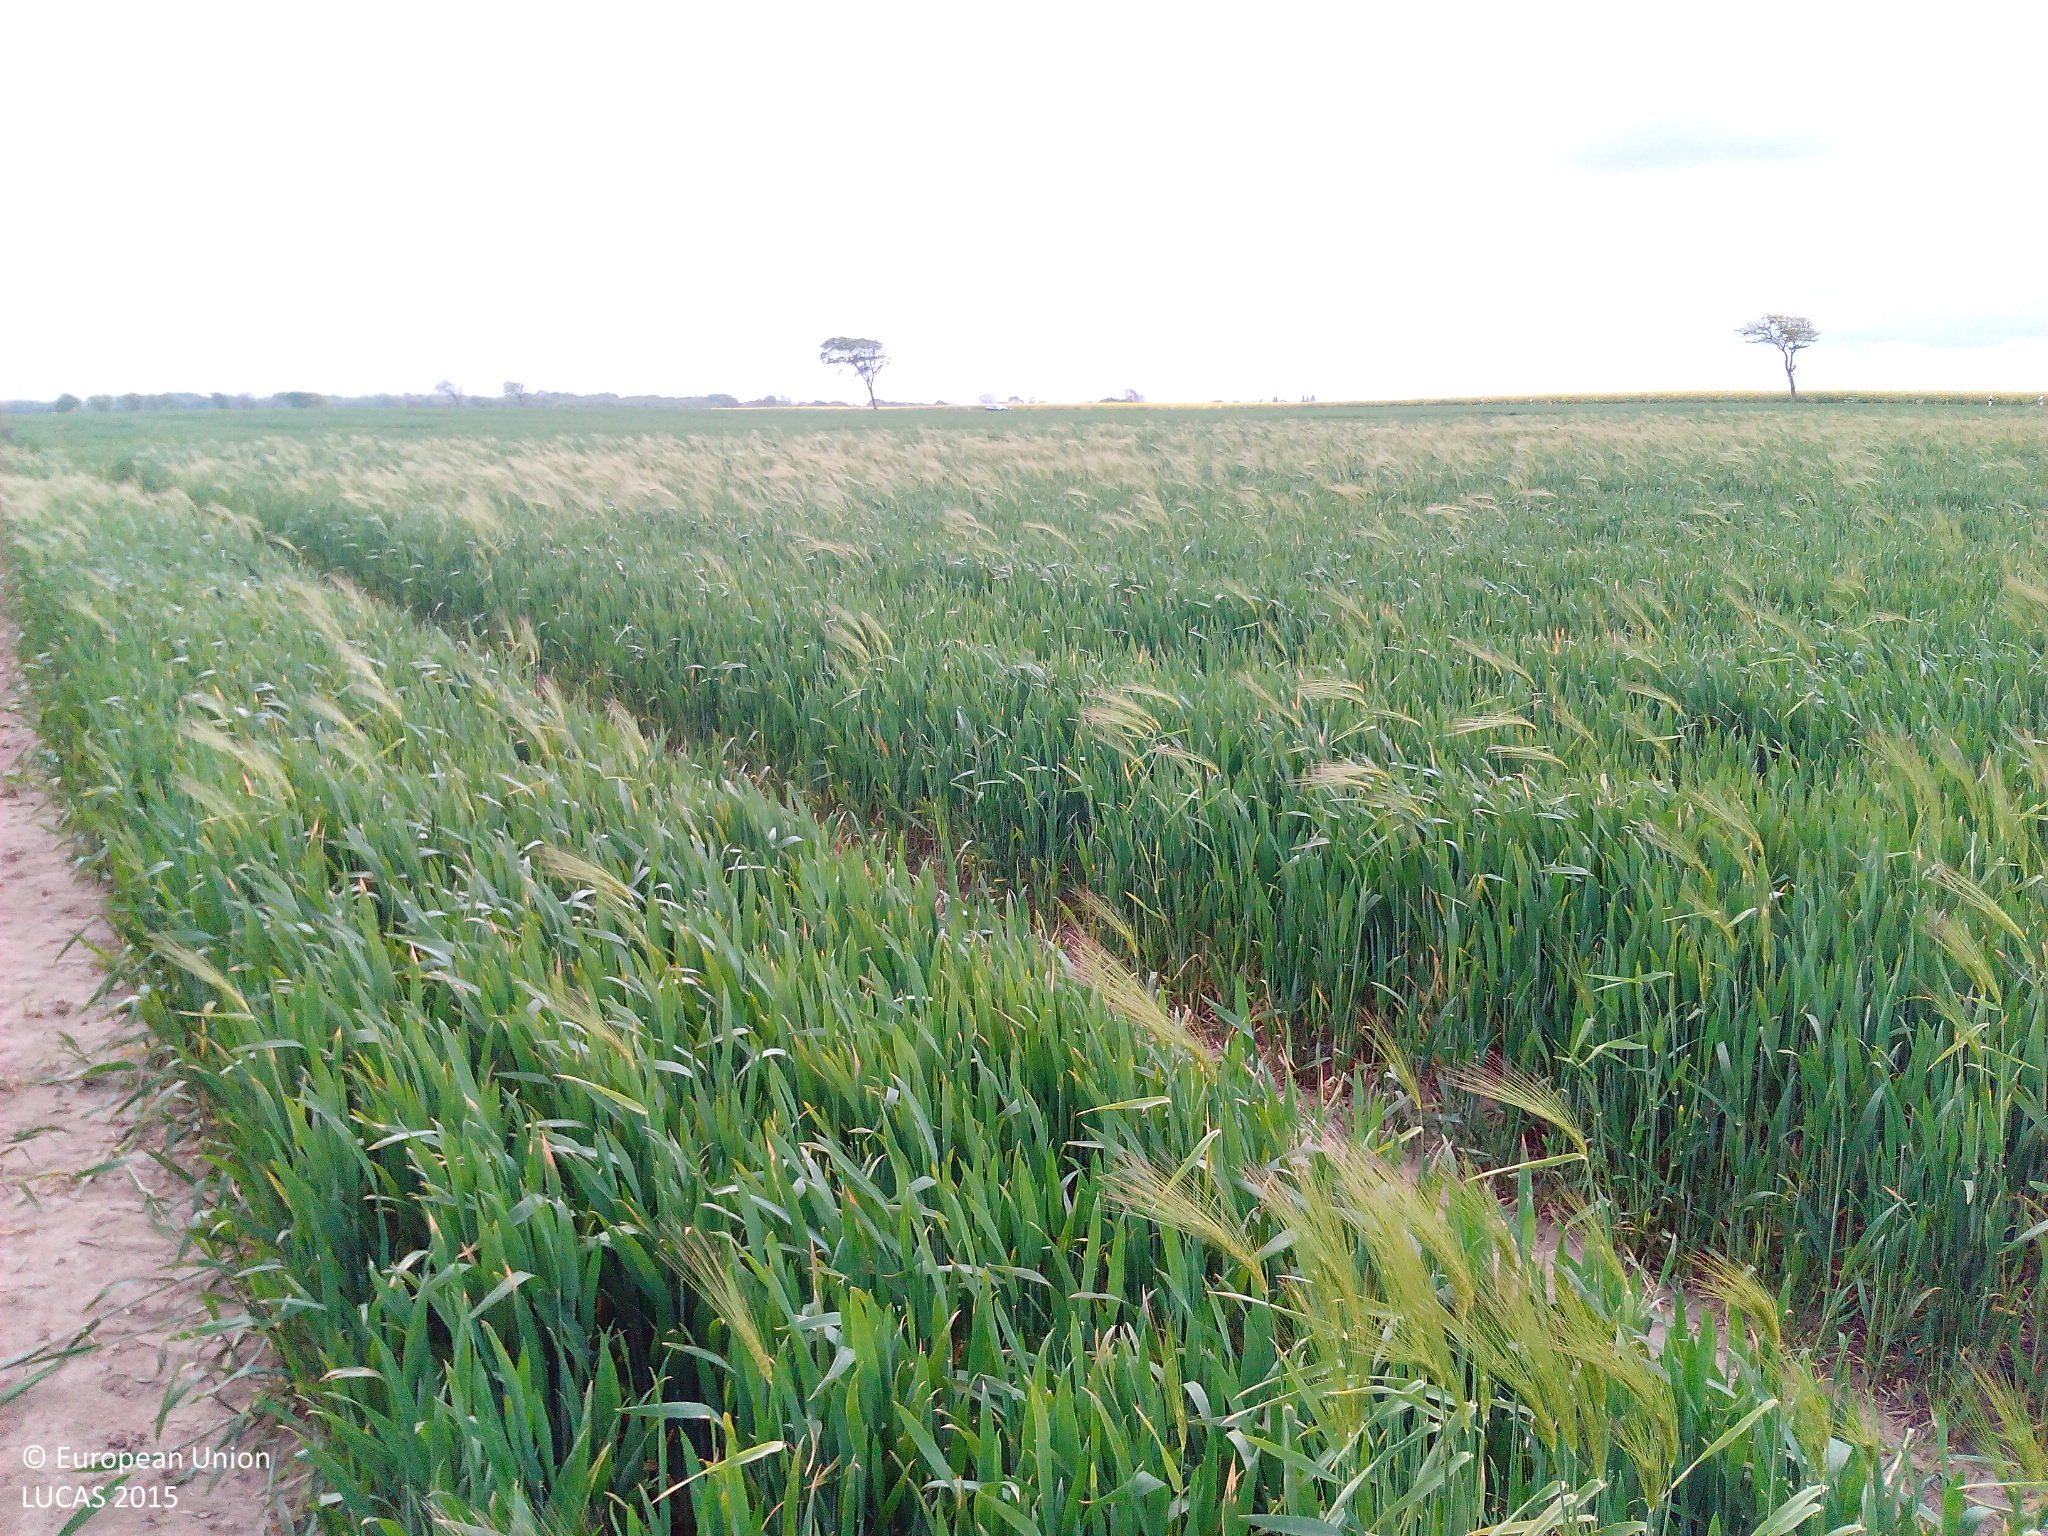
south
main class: Cropland
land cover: Mixed cereals for fodder
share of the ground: > 75 %
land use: Agriculture (excluding fallow land and kitchen gardens)
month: May
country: DE
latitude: 54.4906
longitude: 13.2873
